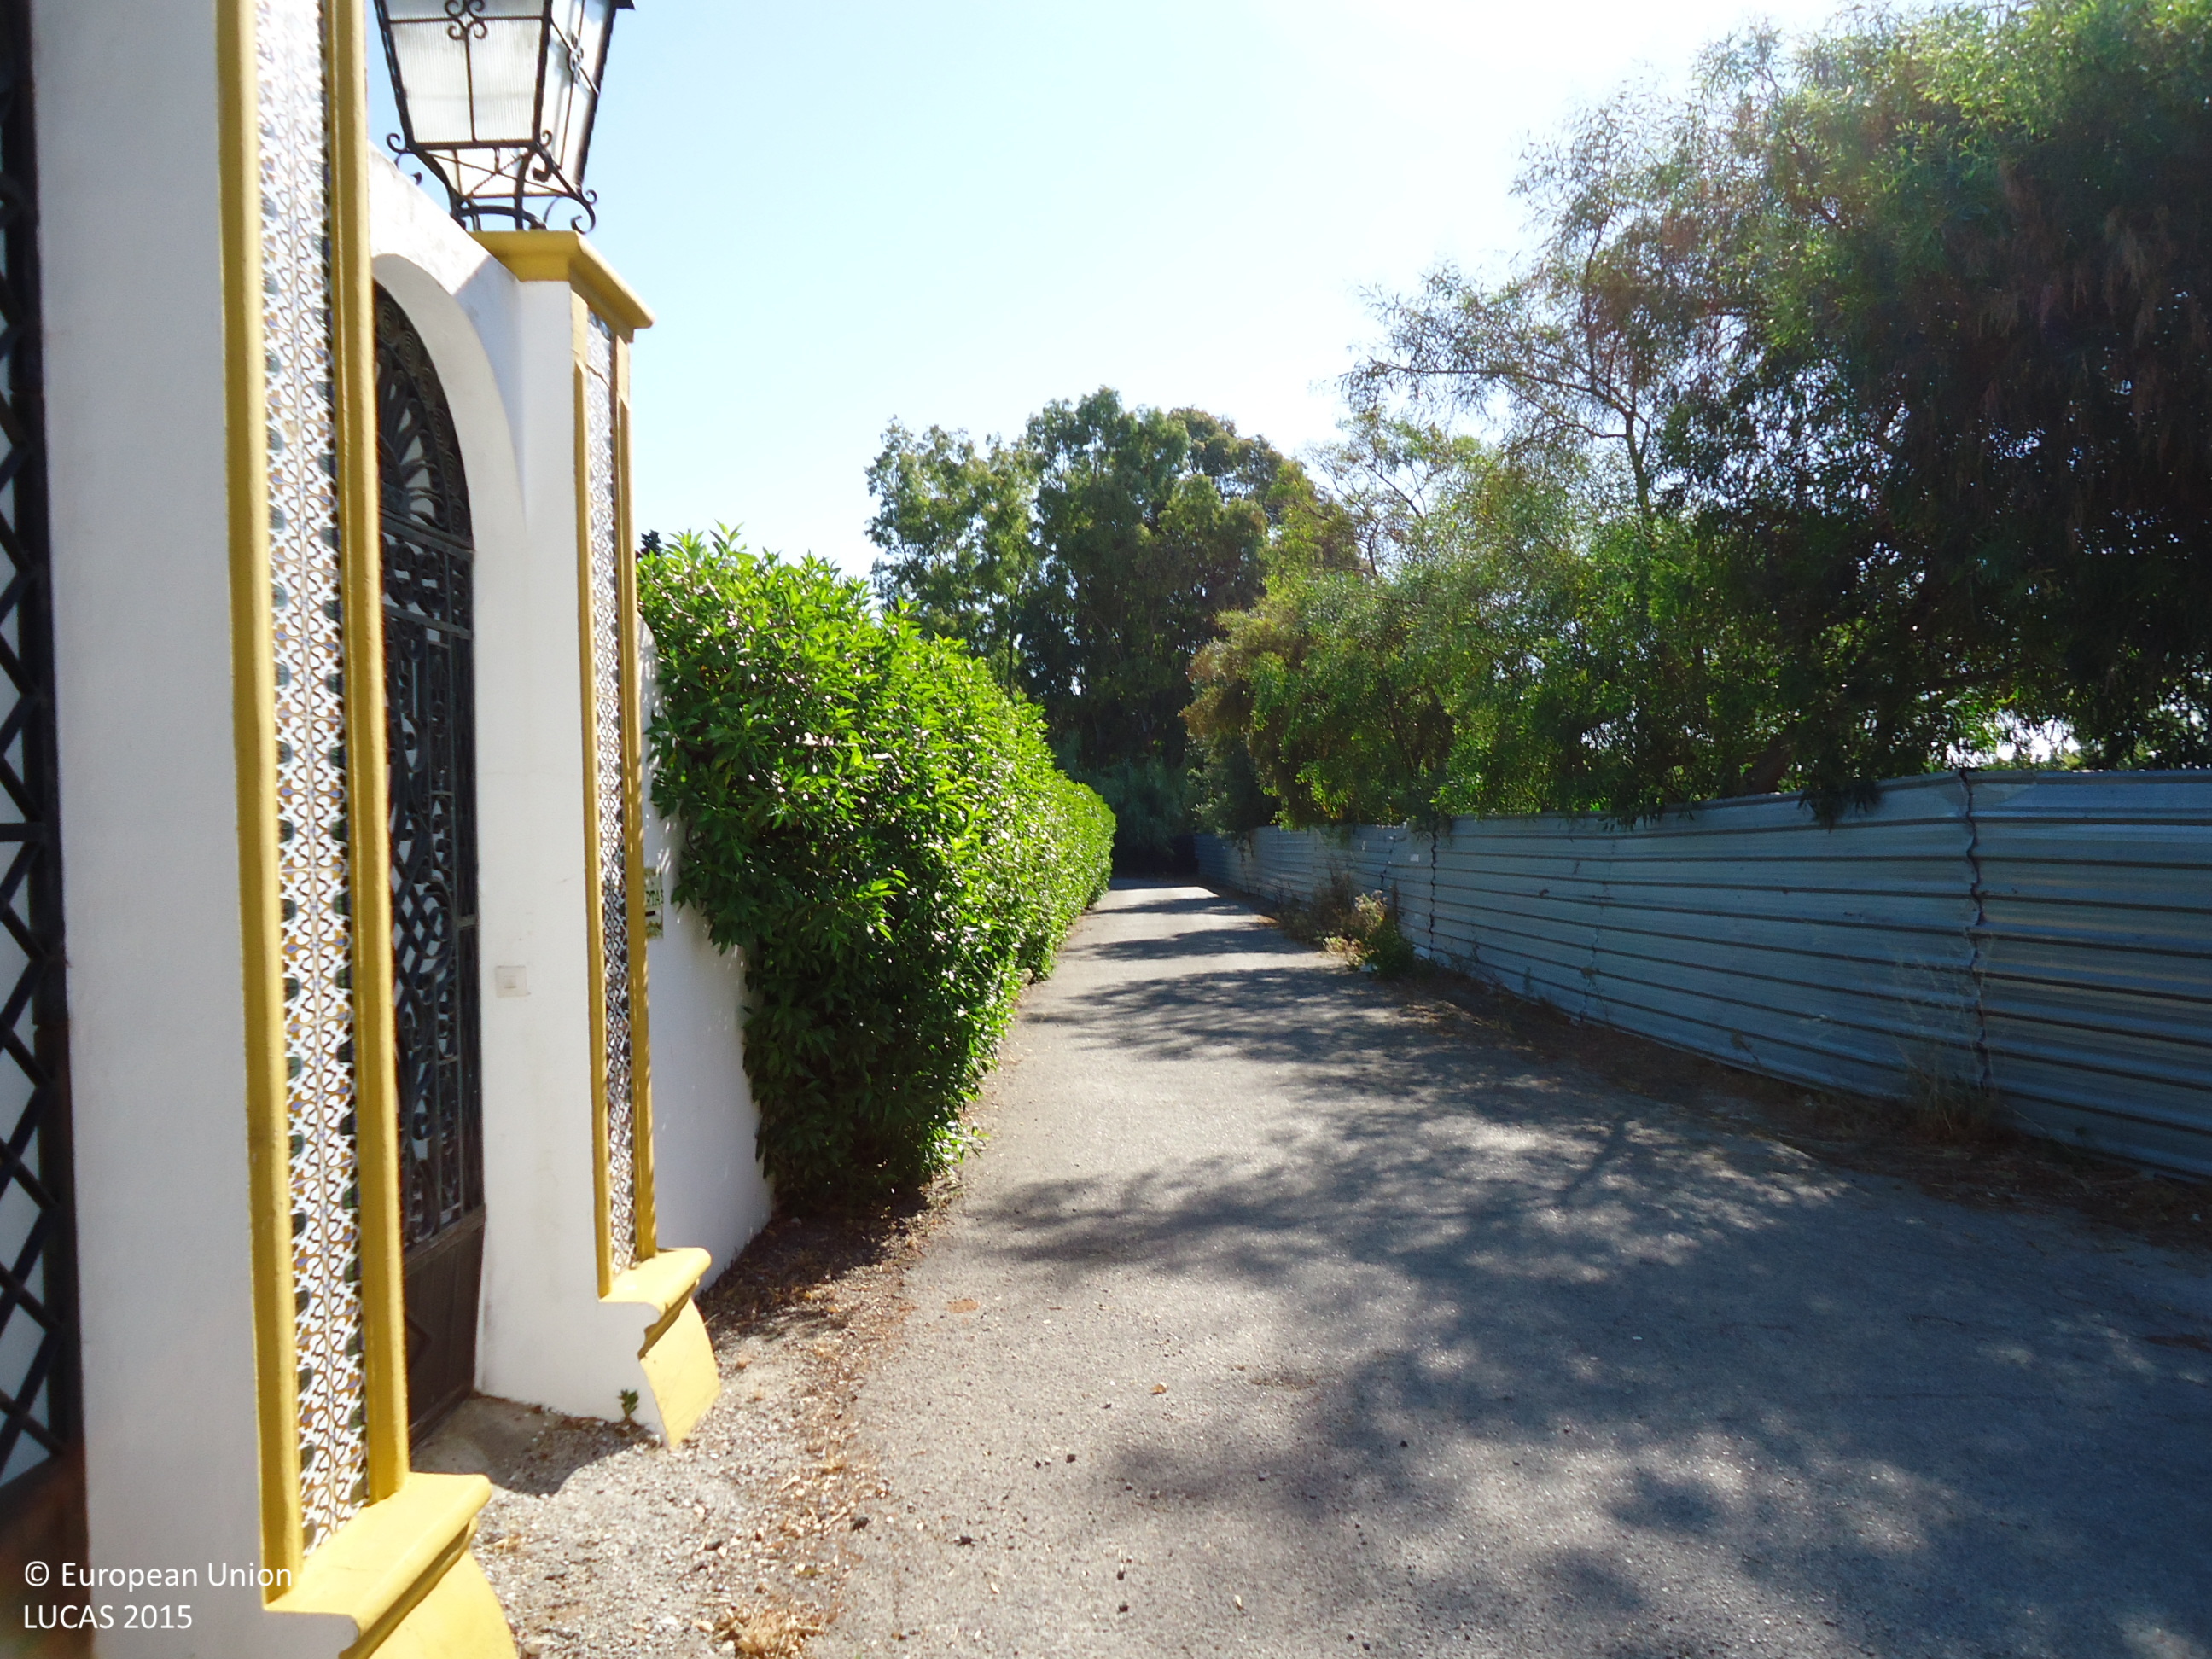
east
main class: Woodland
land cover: Broadleaved woodland
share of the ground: 25 - 50 %
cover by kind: herbaceous plants 70 %, broadleaved forest trees 30 %
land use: Residential
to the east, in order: Broadleaved woodland; Artificial constructions in urban areas
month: June
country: ES
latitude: 36.5081
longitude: -4.9200
